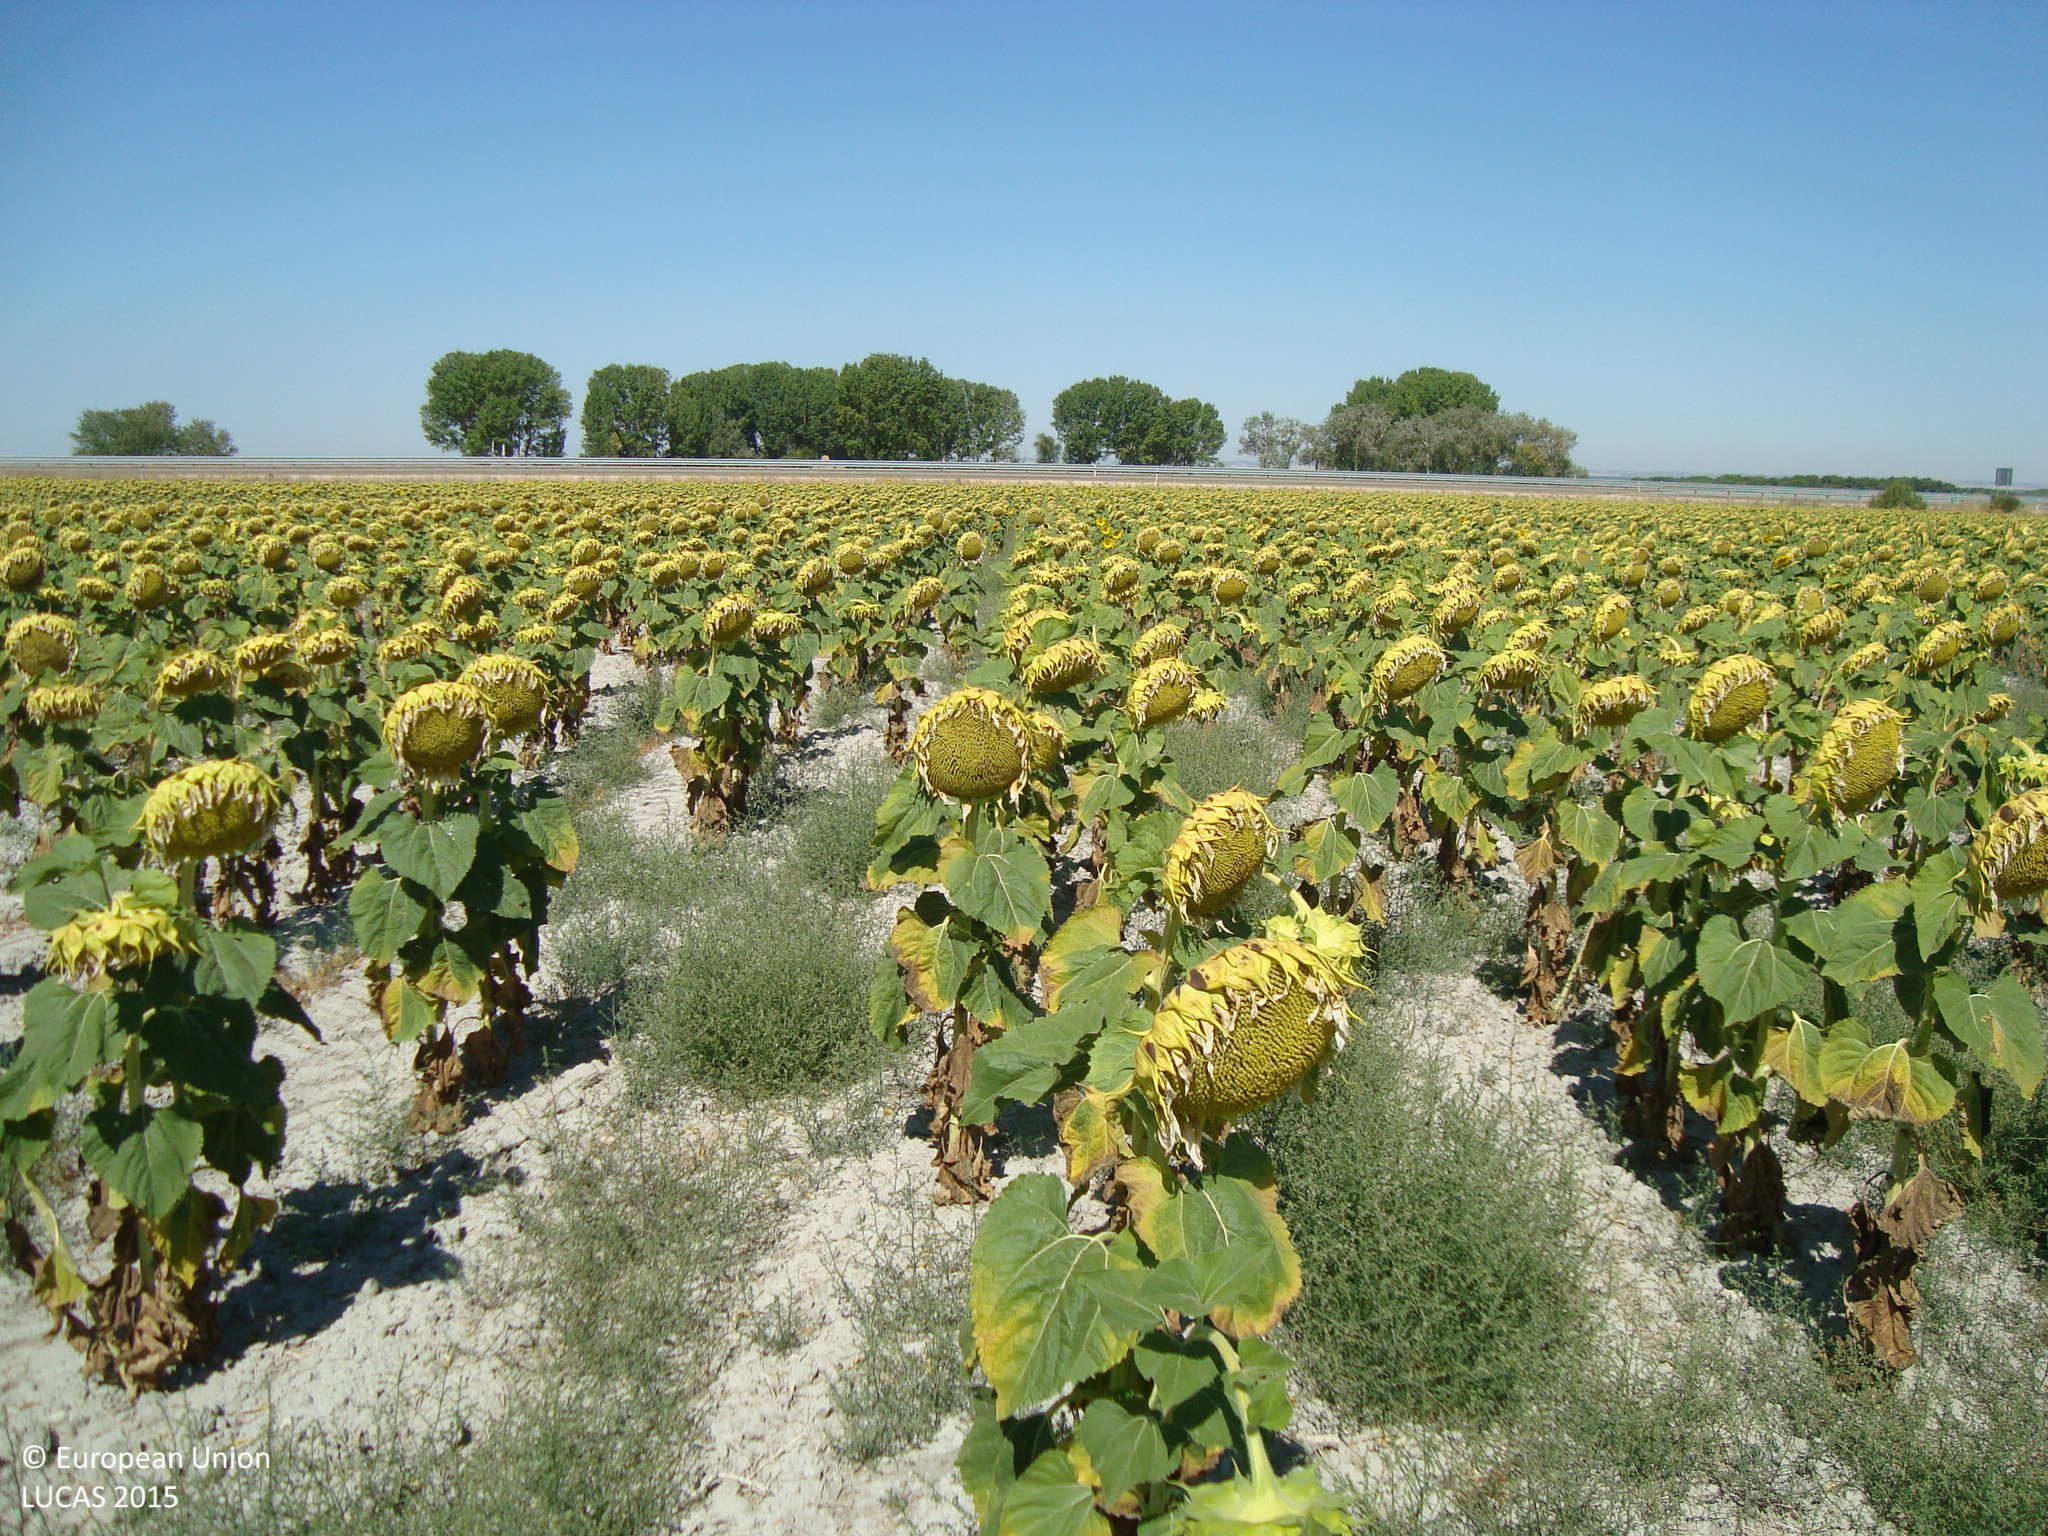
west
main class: Cropland
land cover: Sunflower
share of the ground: > 75 %
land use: Agriculture (excluding fallow land and kitchen gardens)
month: August
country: ES
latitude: 41.4774
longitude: -4.6150
